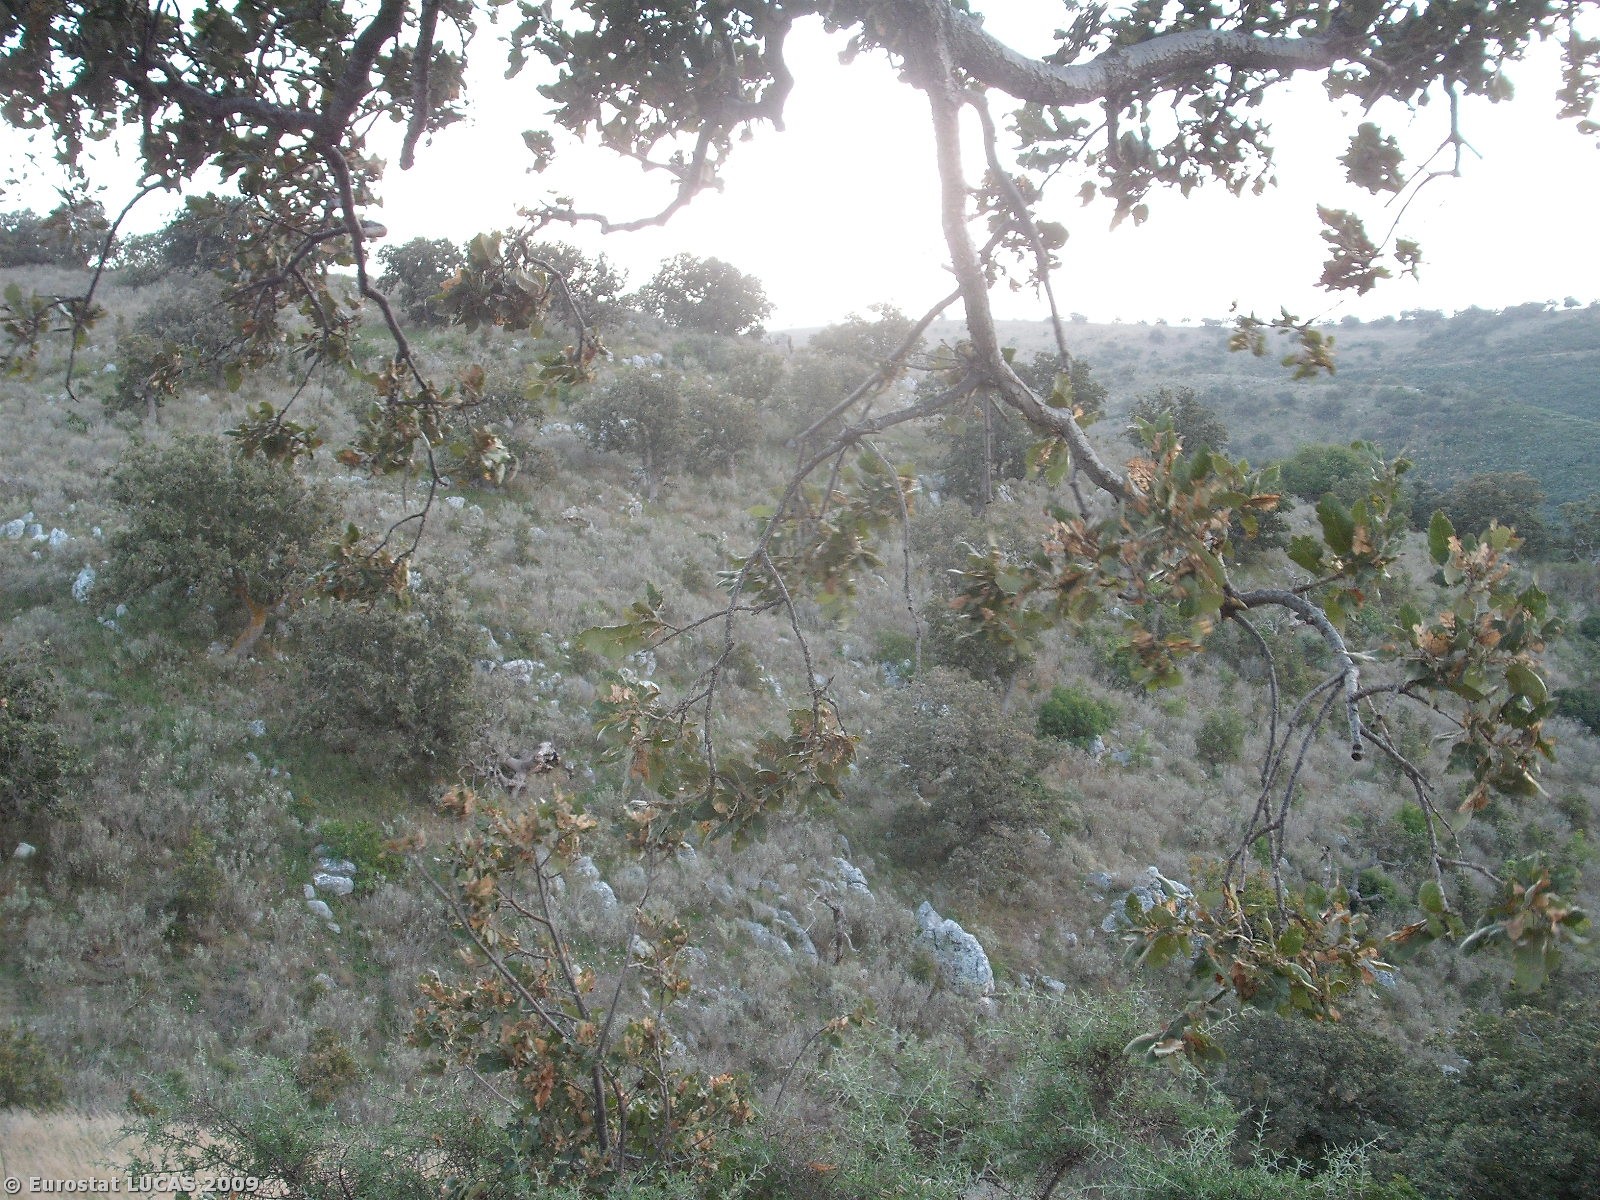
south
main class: Shrubland
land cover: Shrubland without tree cover
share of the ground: > 75 %
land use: Nature reserves
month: October
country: GR
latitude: 38.1792
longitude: 21.3690
